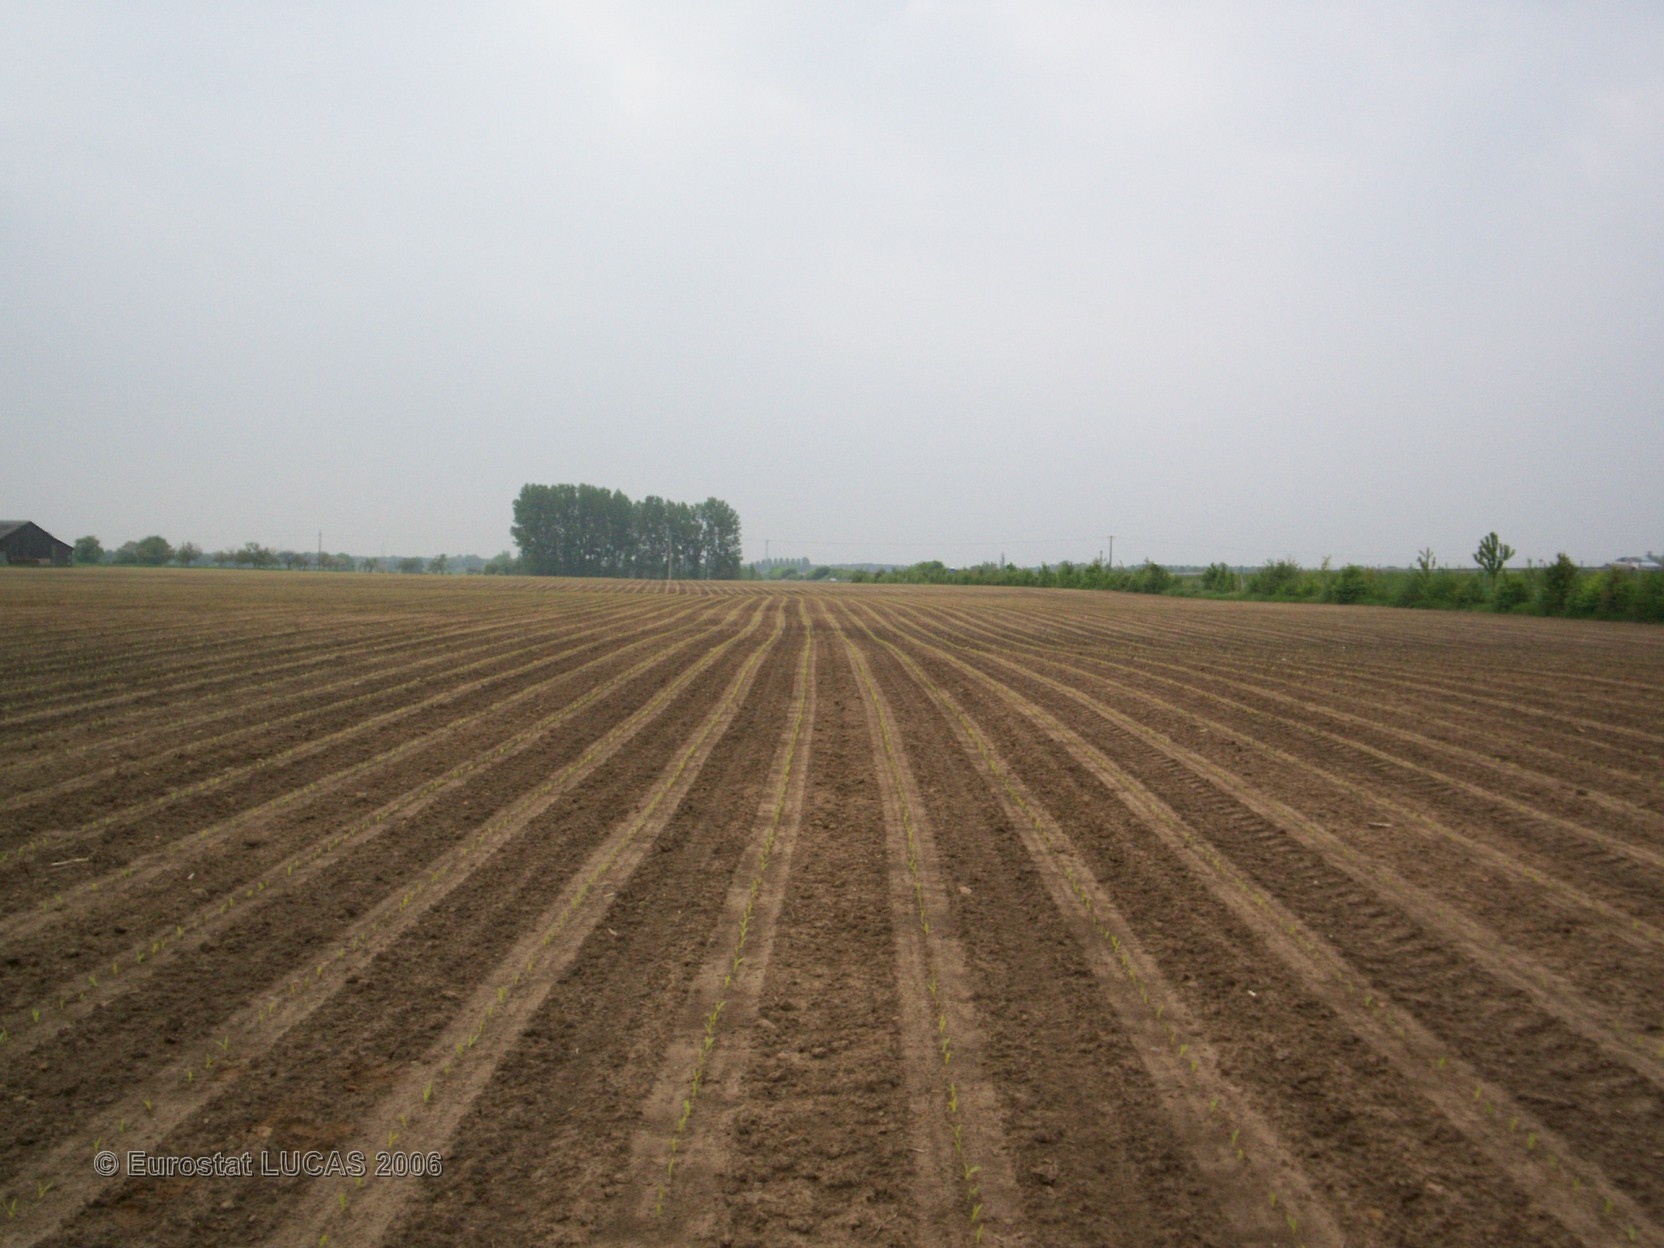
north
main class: Cropland
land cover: Maize
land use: Agriculture (excluding fallow land and kitchen gardens)
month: May
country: FR
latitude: 47.9039
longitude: 0.3031
